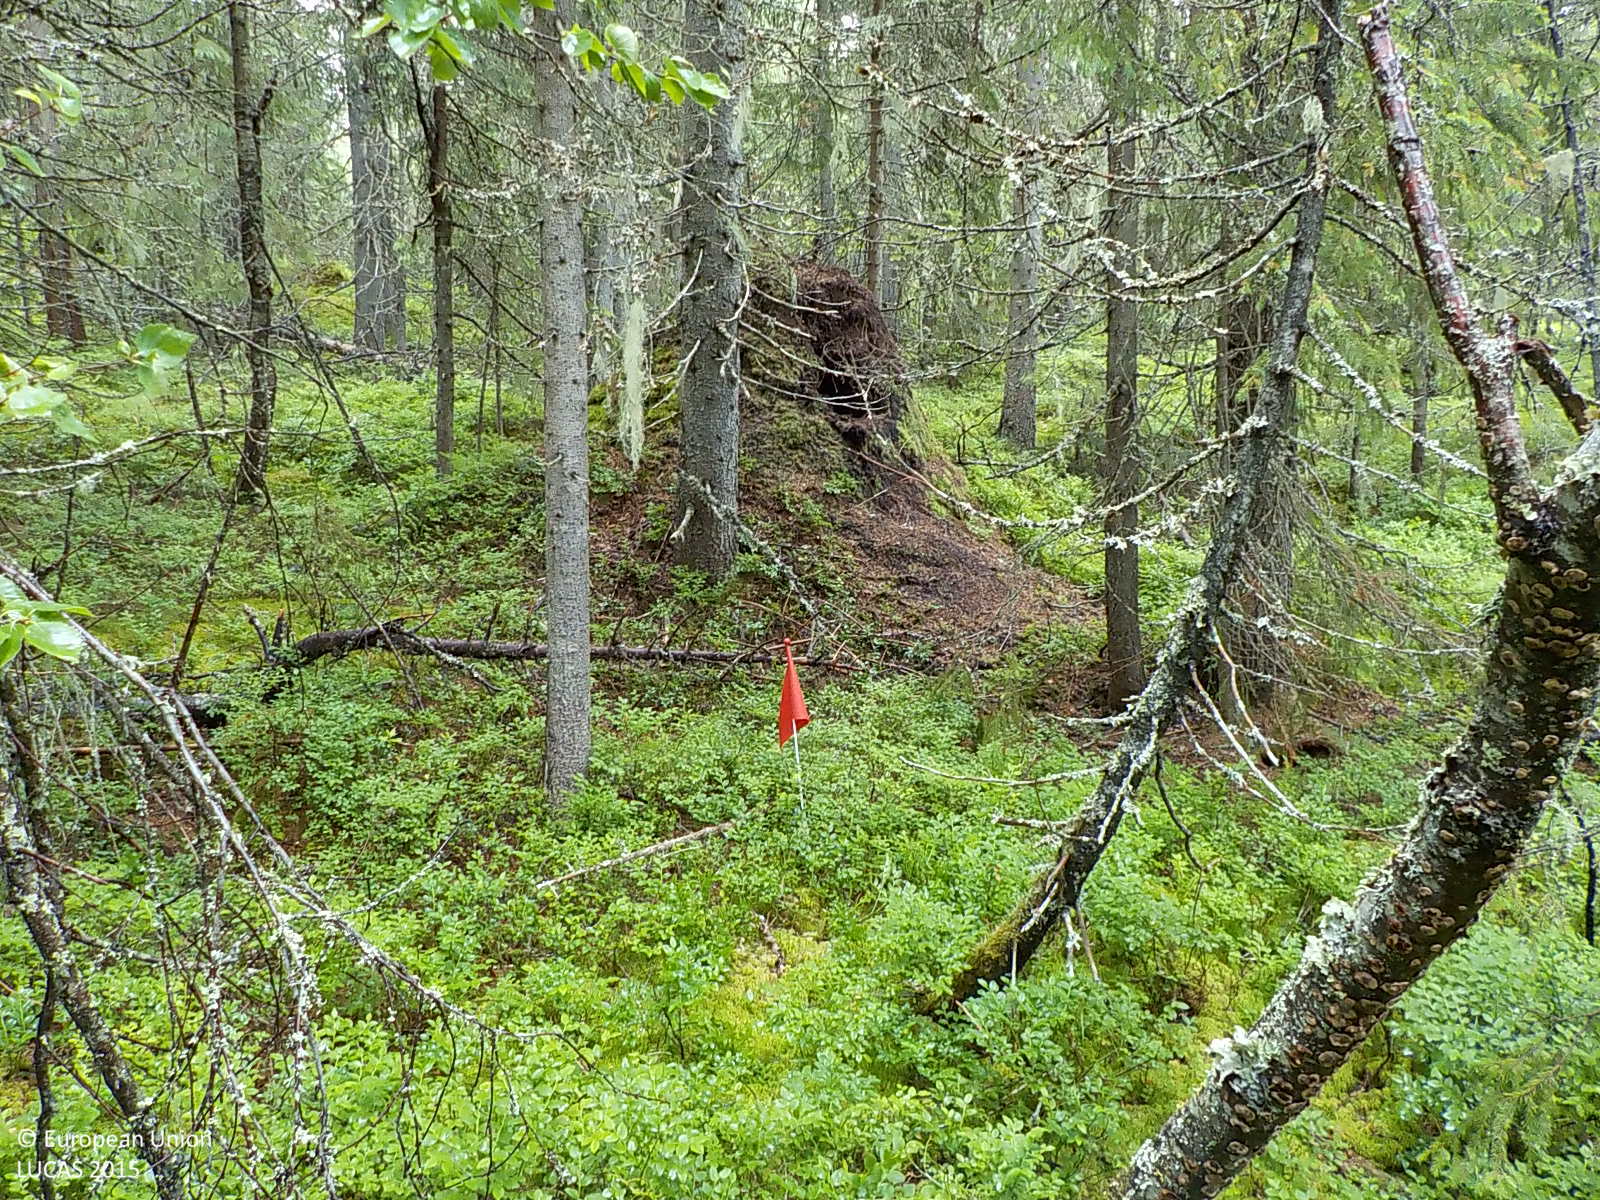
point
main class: Woodland
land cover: Spruce dominated coniferous woodland
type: boreal forest
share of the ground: 50 - 75 %
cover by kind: coniferous forest trees 60 %, shrubs 35 %, broadleaved forest trees 5 %
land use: Forestry
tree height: > 5 m
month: July
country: SE
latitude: 63.1963
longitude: 18.0271
